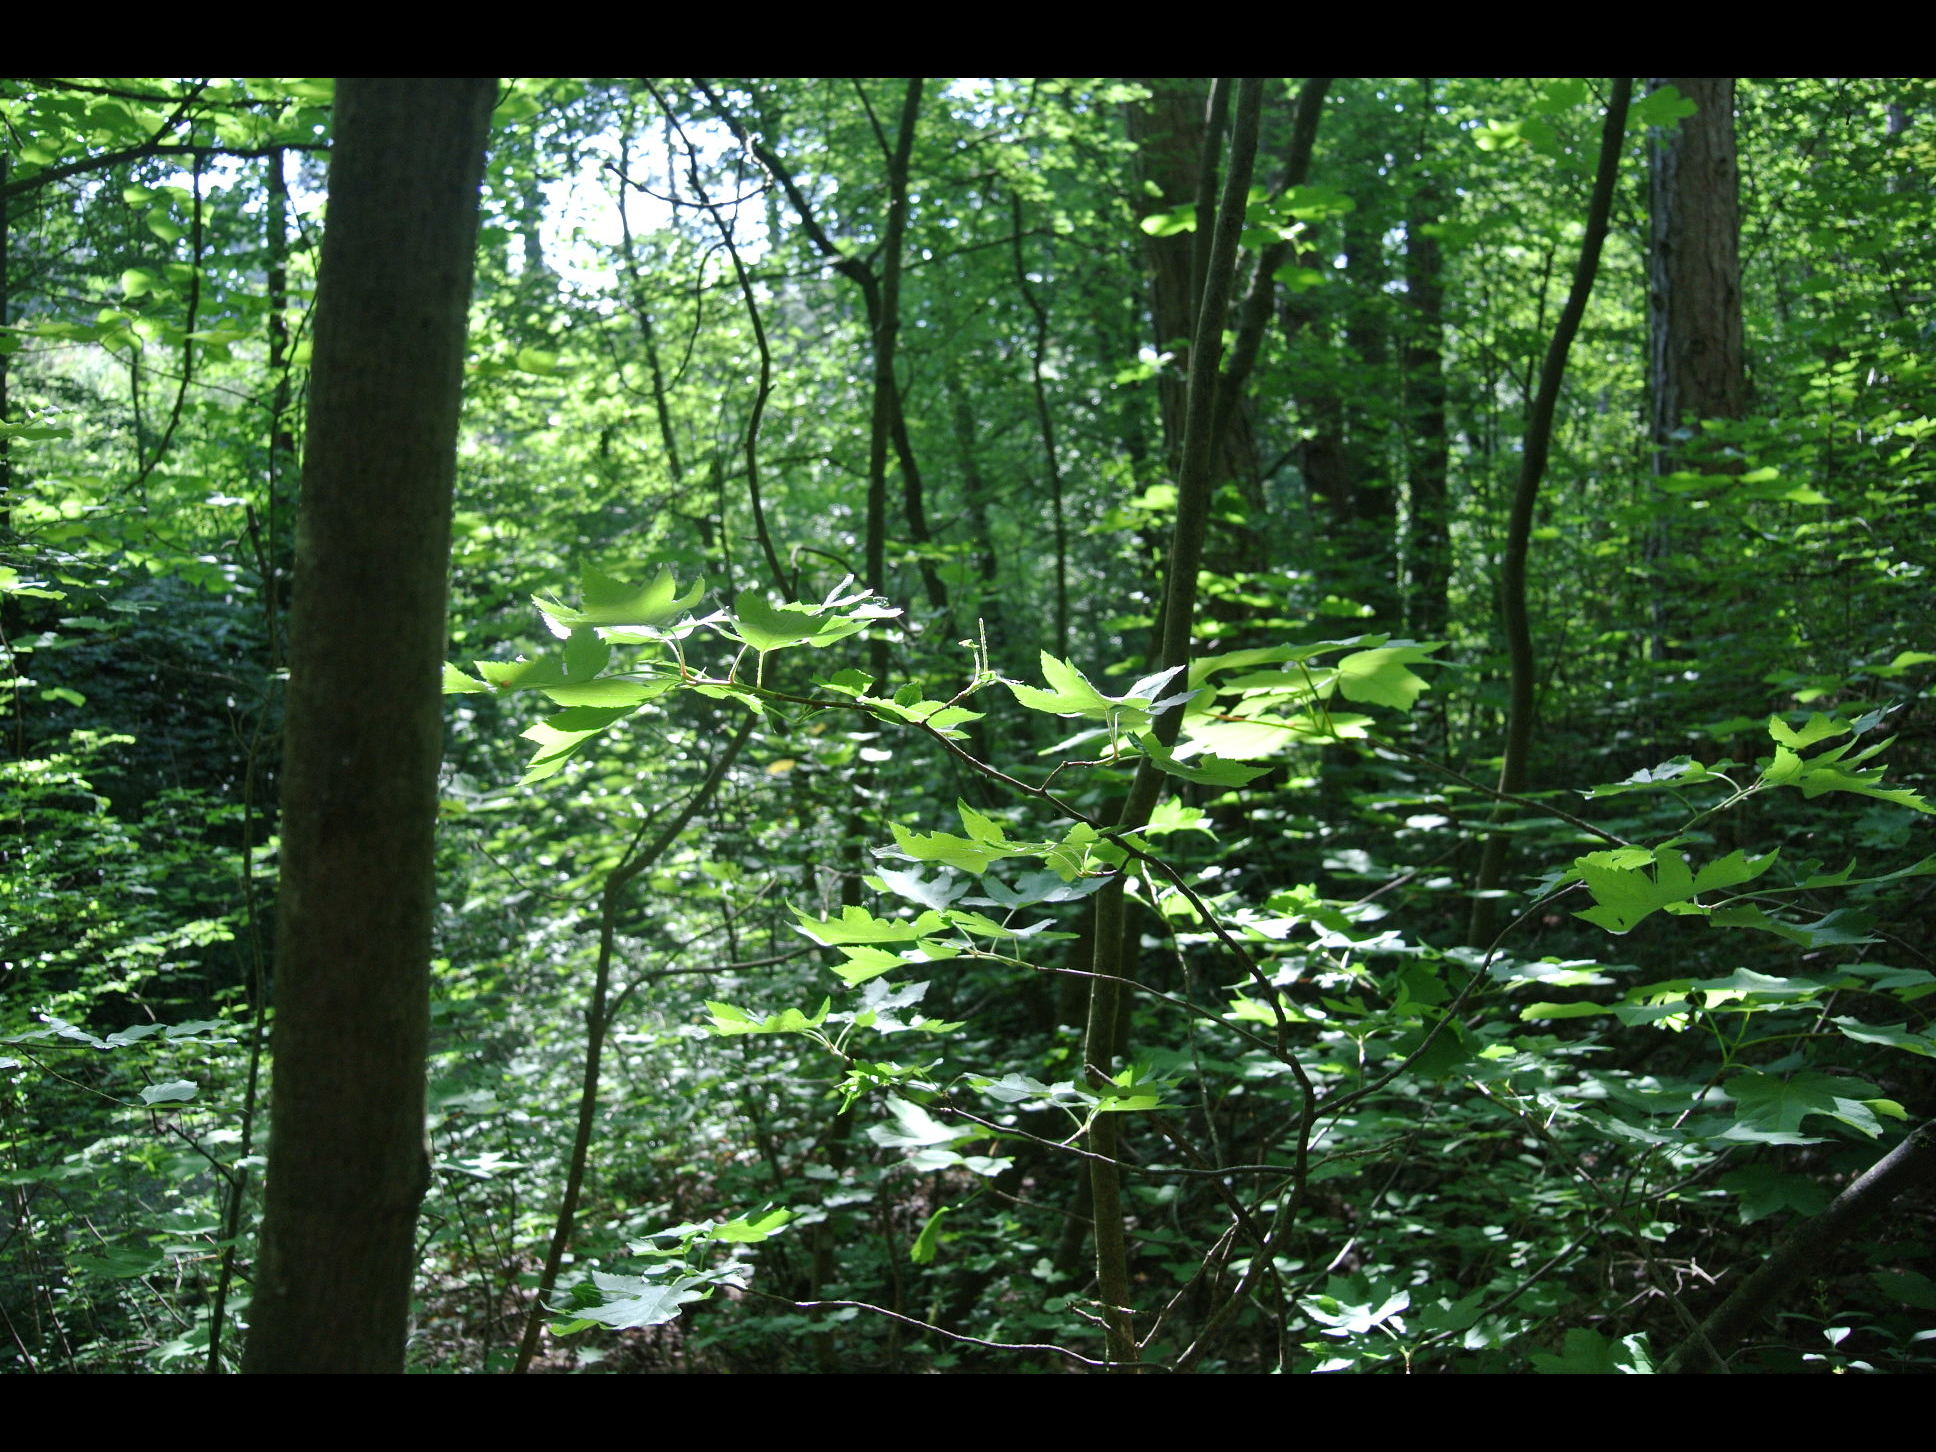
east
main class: Woodland
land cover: Pine dominated mixed woodland
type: alpine coniferous forest
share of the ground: > 75 %
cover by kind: broadleaved forest trees 75 %, coniferous forest trees 25 %
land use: Forestry
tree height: > 5 m
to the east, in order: Pine dominated mixed woodland; Tracks; Pine dominated mixed woodland; Grassland with sparse tree/shrub cover; Grassland without tree/shrub cover; Artificial constructions in urban areas; Grassland without tree/shrub cover; Pine dominated mixed woodland; Pine dominated coniferous woodland; Paved roads, cycling and walking lanes; Pine dominated mixed woodland
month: May
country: AT
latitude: 47.8346
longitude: 16.1625
